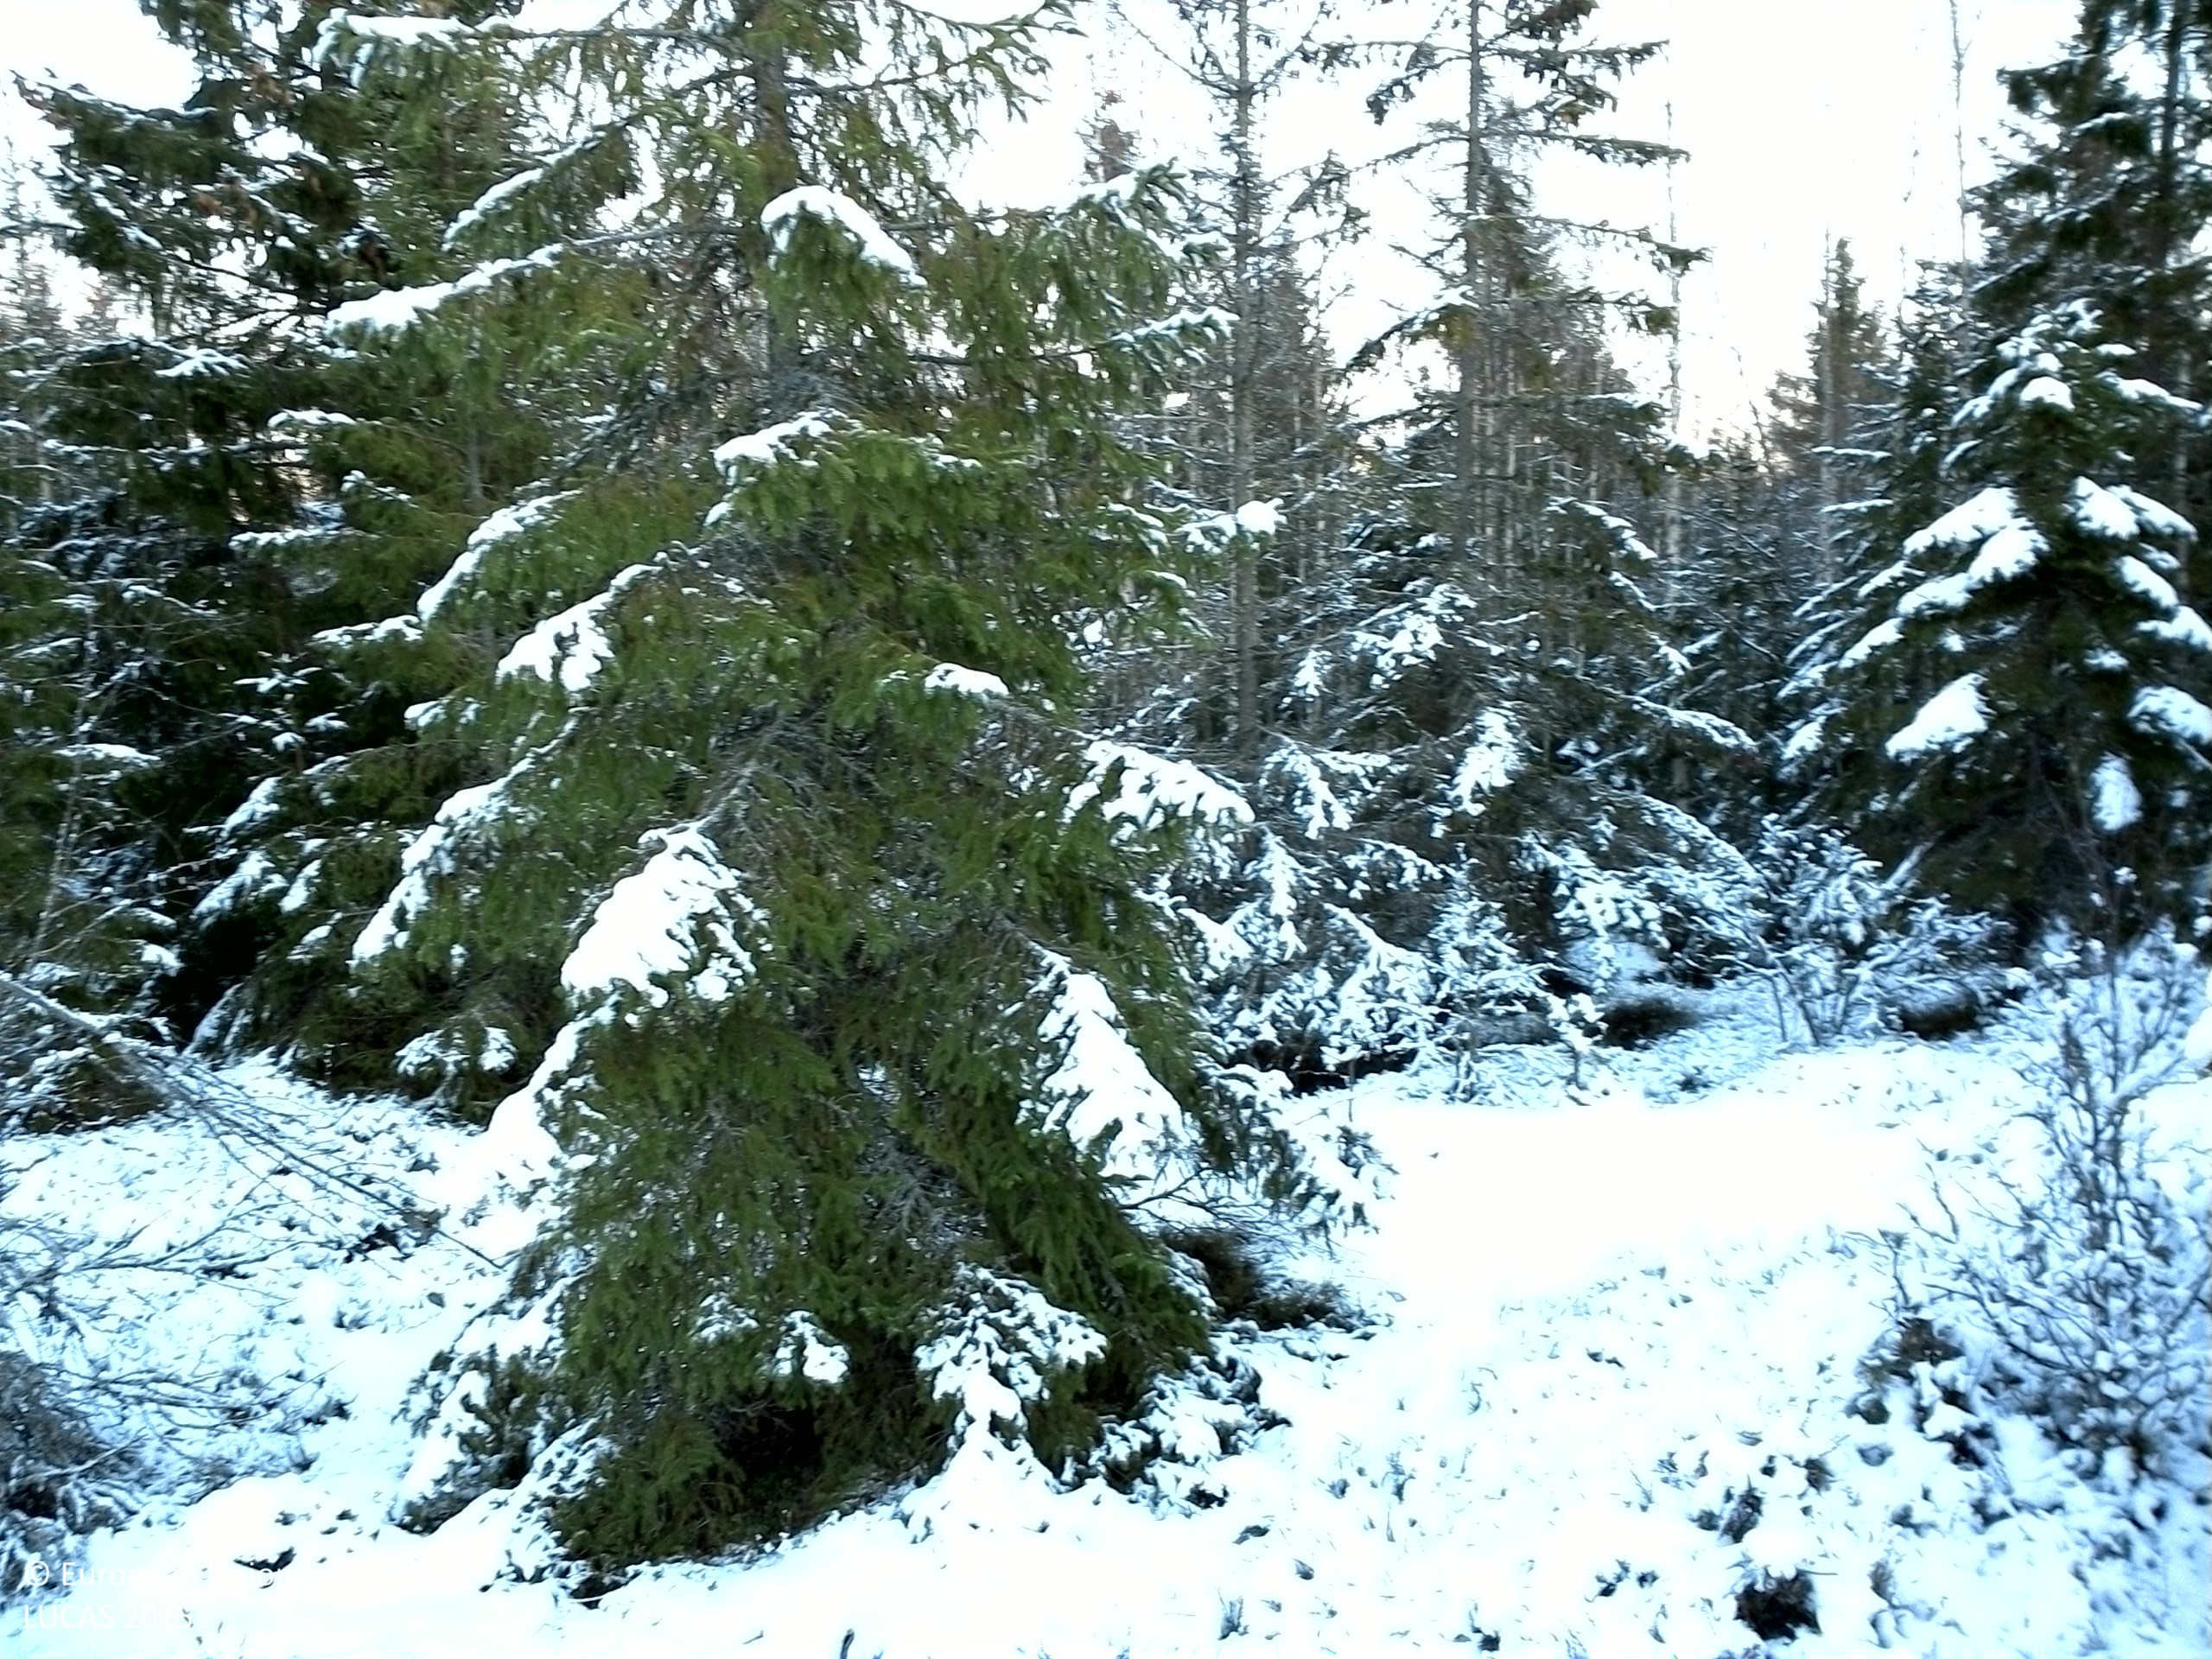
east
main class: Woodland
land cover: Spruce dominated mixed woodland
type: boreal forest
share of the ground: 50 - 75 %
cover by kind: coniferous forest trees 40 %, consolidated bare surface 20 %, broadleaved forest trees 15 %, shrubs 15 %, herbaceous plants 5 %, lichens and mosses 5 %
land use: Semi-natural and natural areas not in use
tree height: > 5 m
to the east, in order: Spruce dominated mixed woodland; Other mixed woodland; Spruce dominated mixed woodland; Other mixed woodland
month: December
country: SE
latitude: 59.6414
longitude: 16.3243
